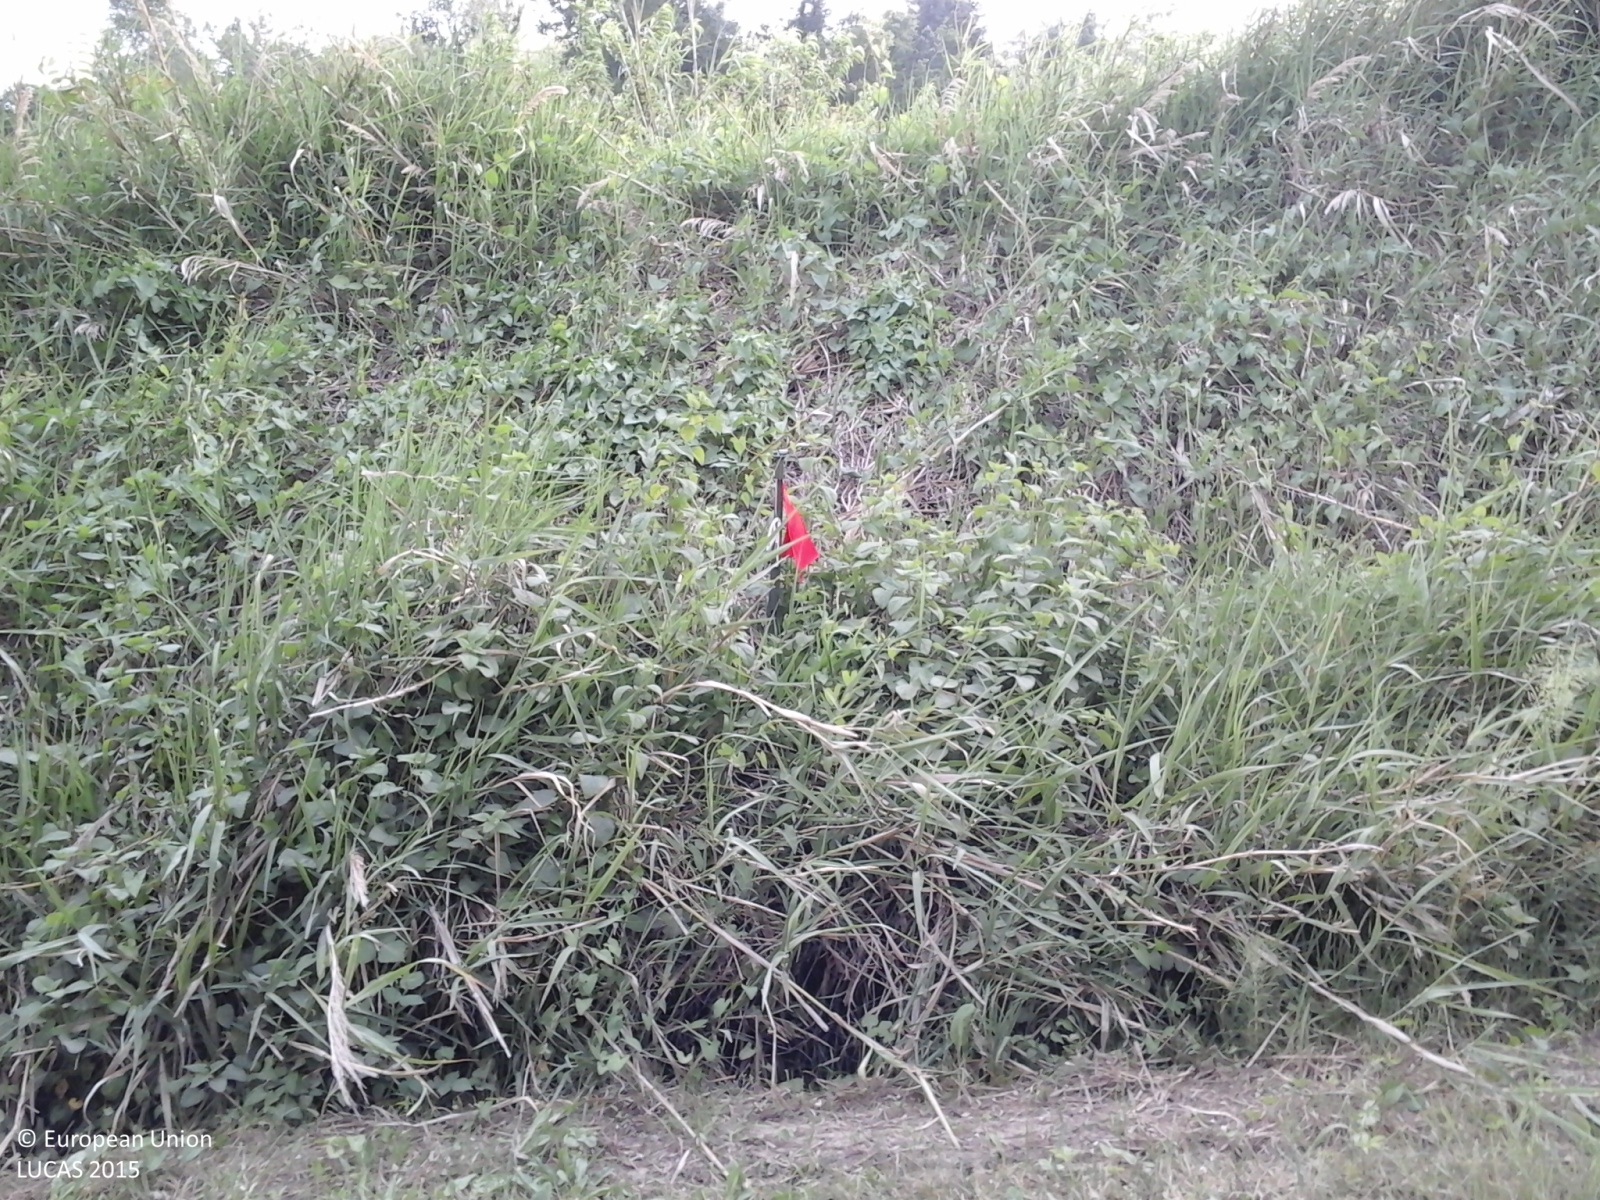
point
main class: Grassland
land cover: Spontaneously vegetated surfaces
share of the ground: > 75 %
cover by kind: herbaceous plants 100 %
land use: Semi-natural and natural areas not in use
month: May
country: IT
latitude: 44.1165
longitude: 11.9073
